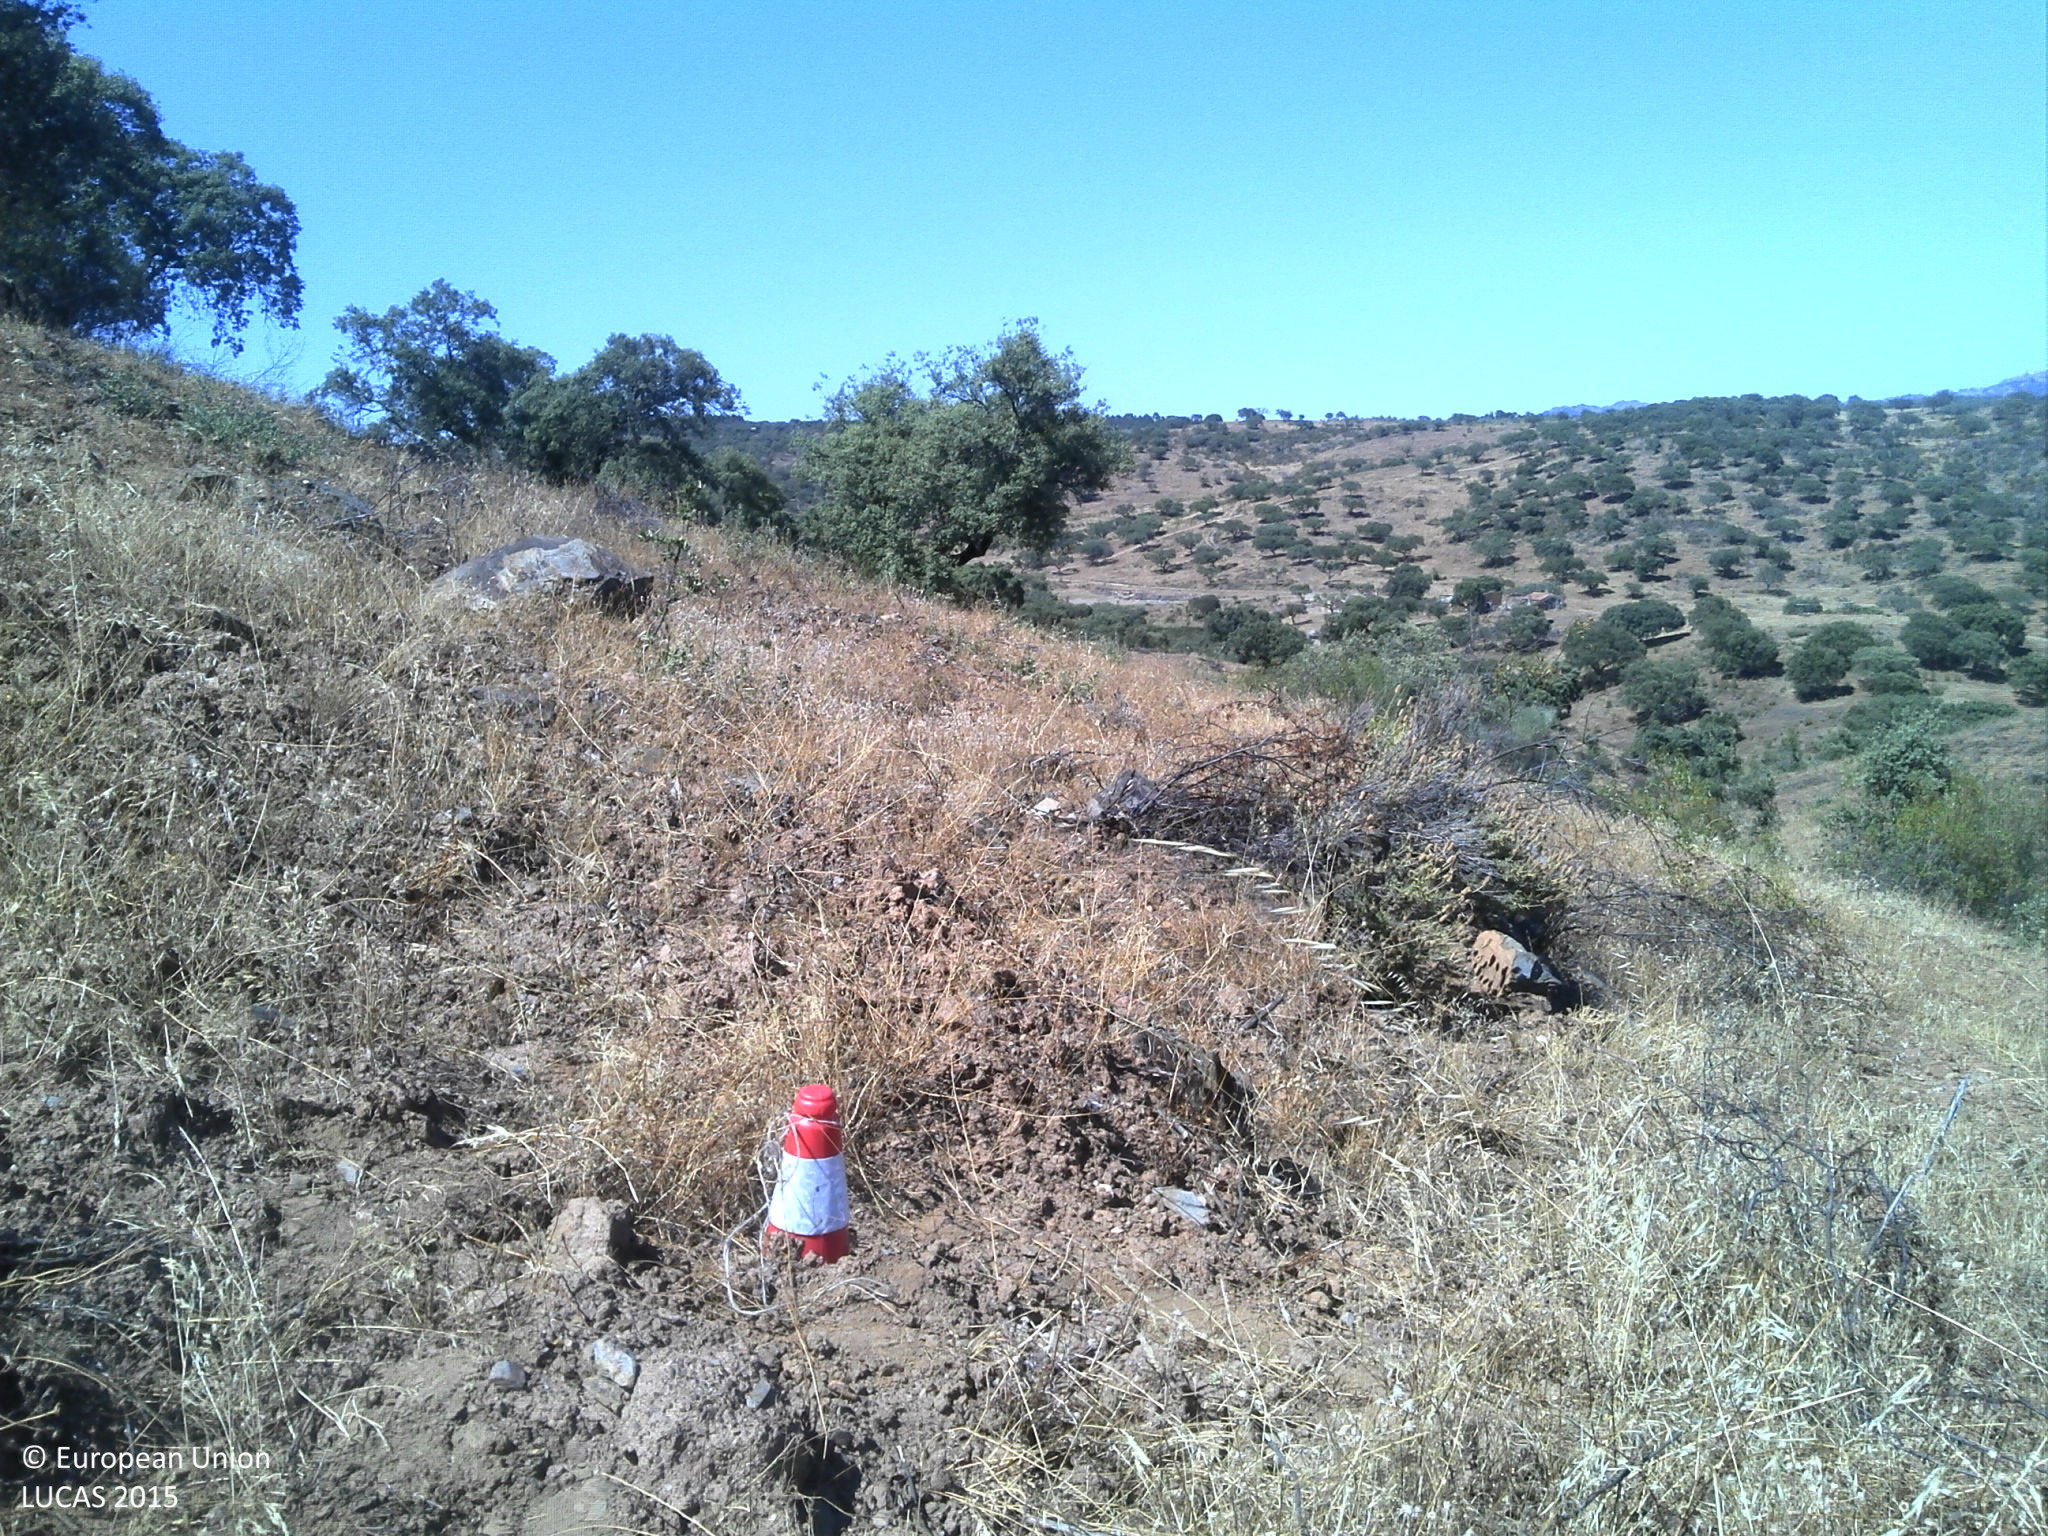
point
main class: Grassland
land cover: Grassland with sparse tree/shrub cover
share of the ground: 25 - 50 %
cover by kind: herbaceous plants 40 %, unconsolidated bare surface 40 %, broadleaved forest trees 5 %, shrubs 5 %
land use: Agriculture (excluding fallow land and kitchen gardens)
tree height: < 5 m
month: June
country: PT
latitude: 39.9889
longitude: -7.2054
